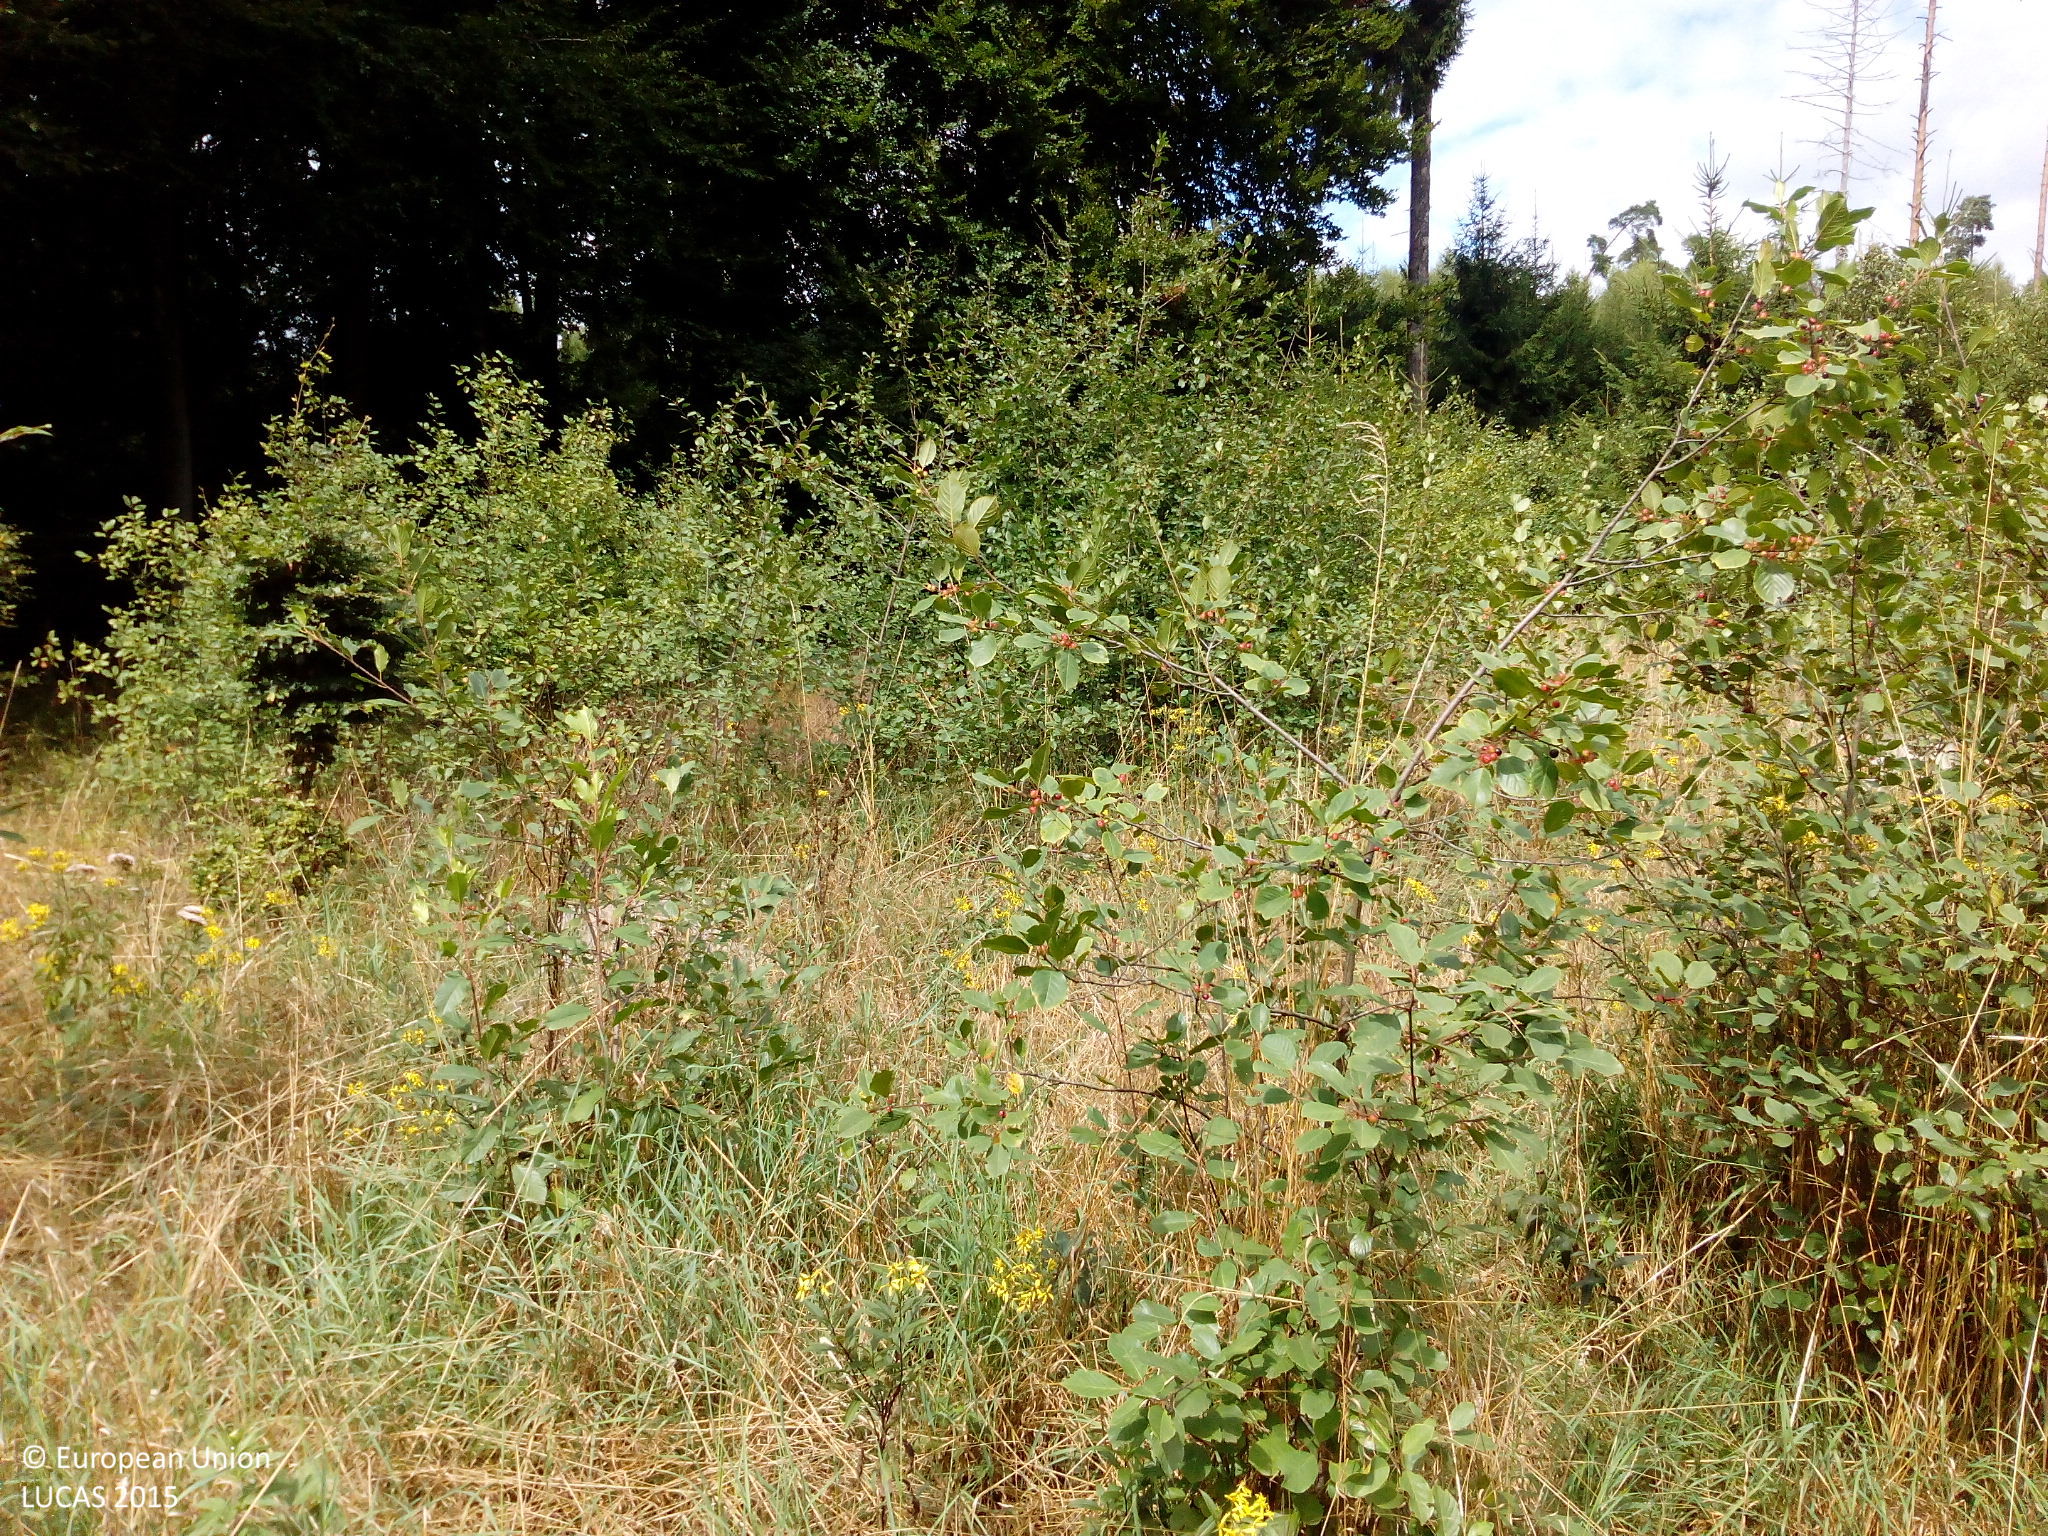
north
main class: Shrubland
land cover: Shrubland with sparse tree cover
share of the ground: > 75 %
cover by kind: shrubs 70 %, herbaceous plants 25 %, broadleaved forest trees 5 %
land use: Forestry
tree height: < 5 m
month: August
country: DE
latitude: 50.0861
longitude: 7.5545
